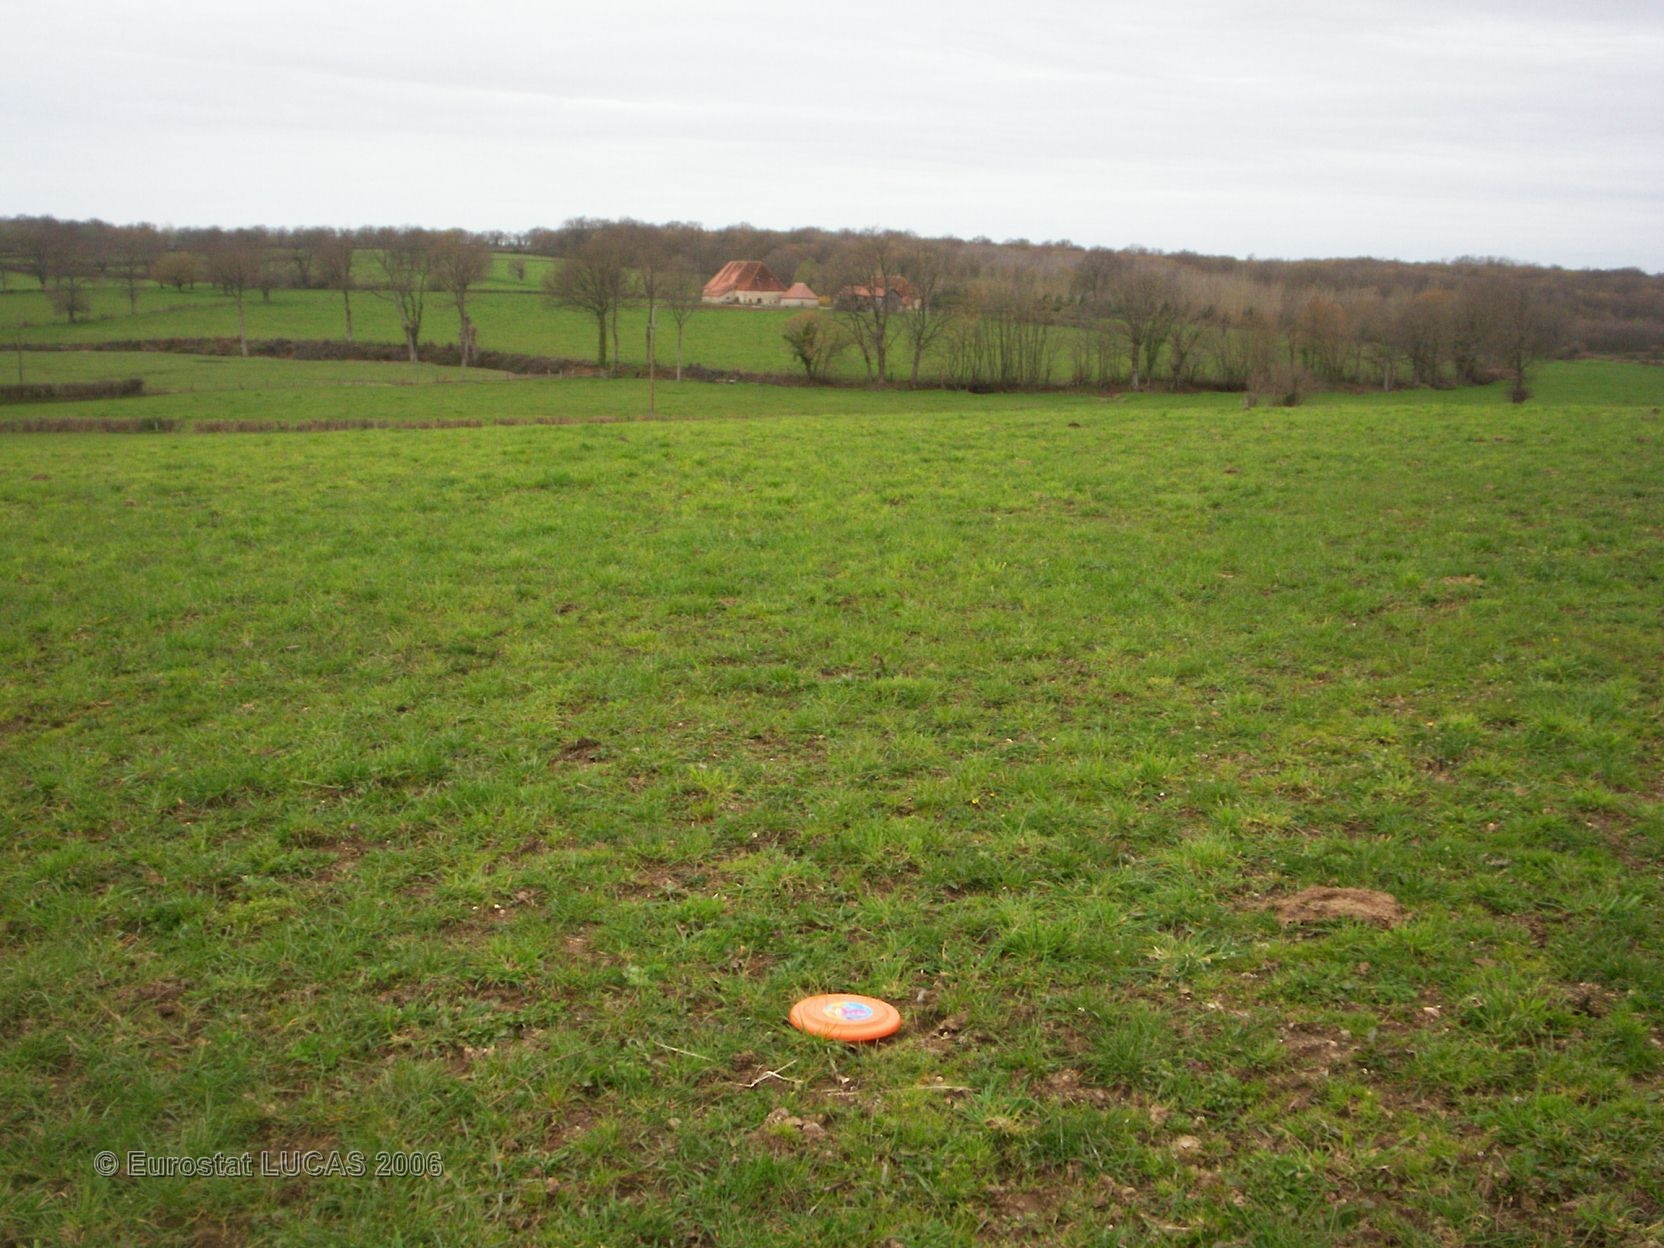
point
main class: Grassland
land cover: Grassland without tree/shrub cover
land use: Agriculture (excluding fallow land and kitchen gardens)
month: April
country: FR
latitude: 46.7085
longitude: 3.1299
